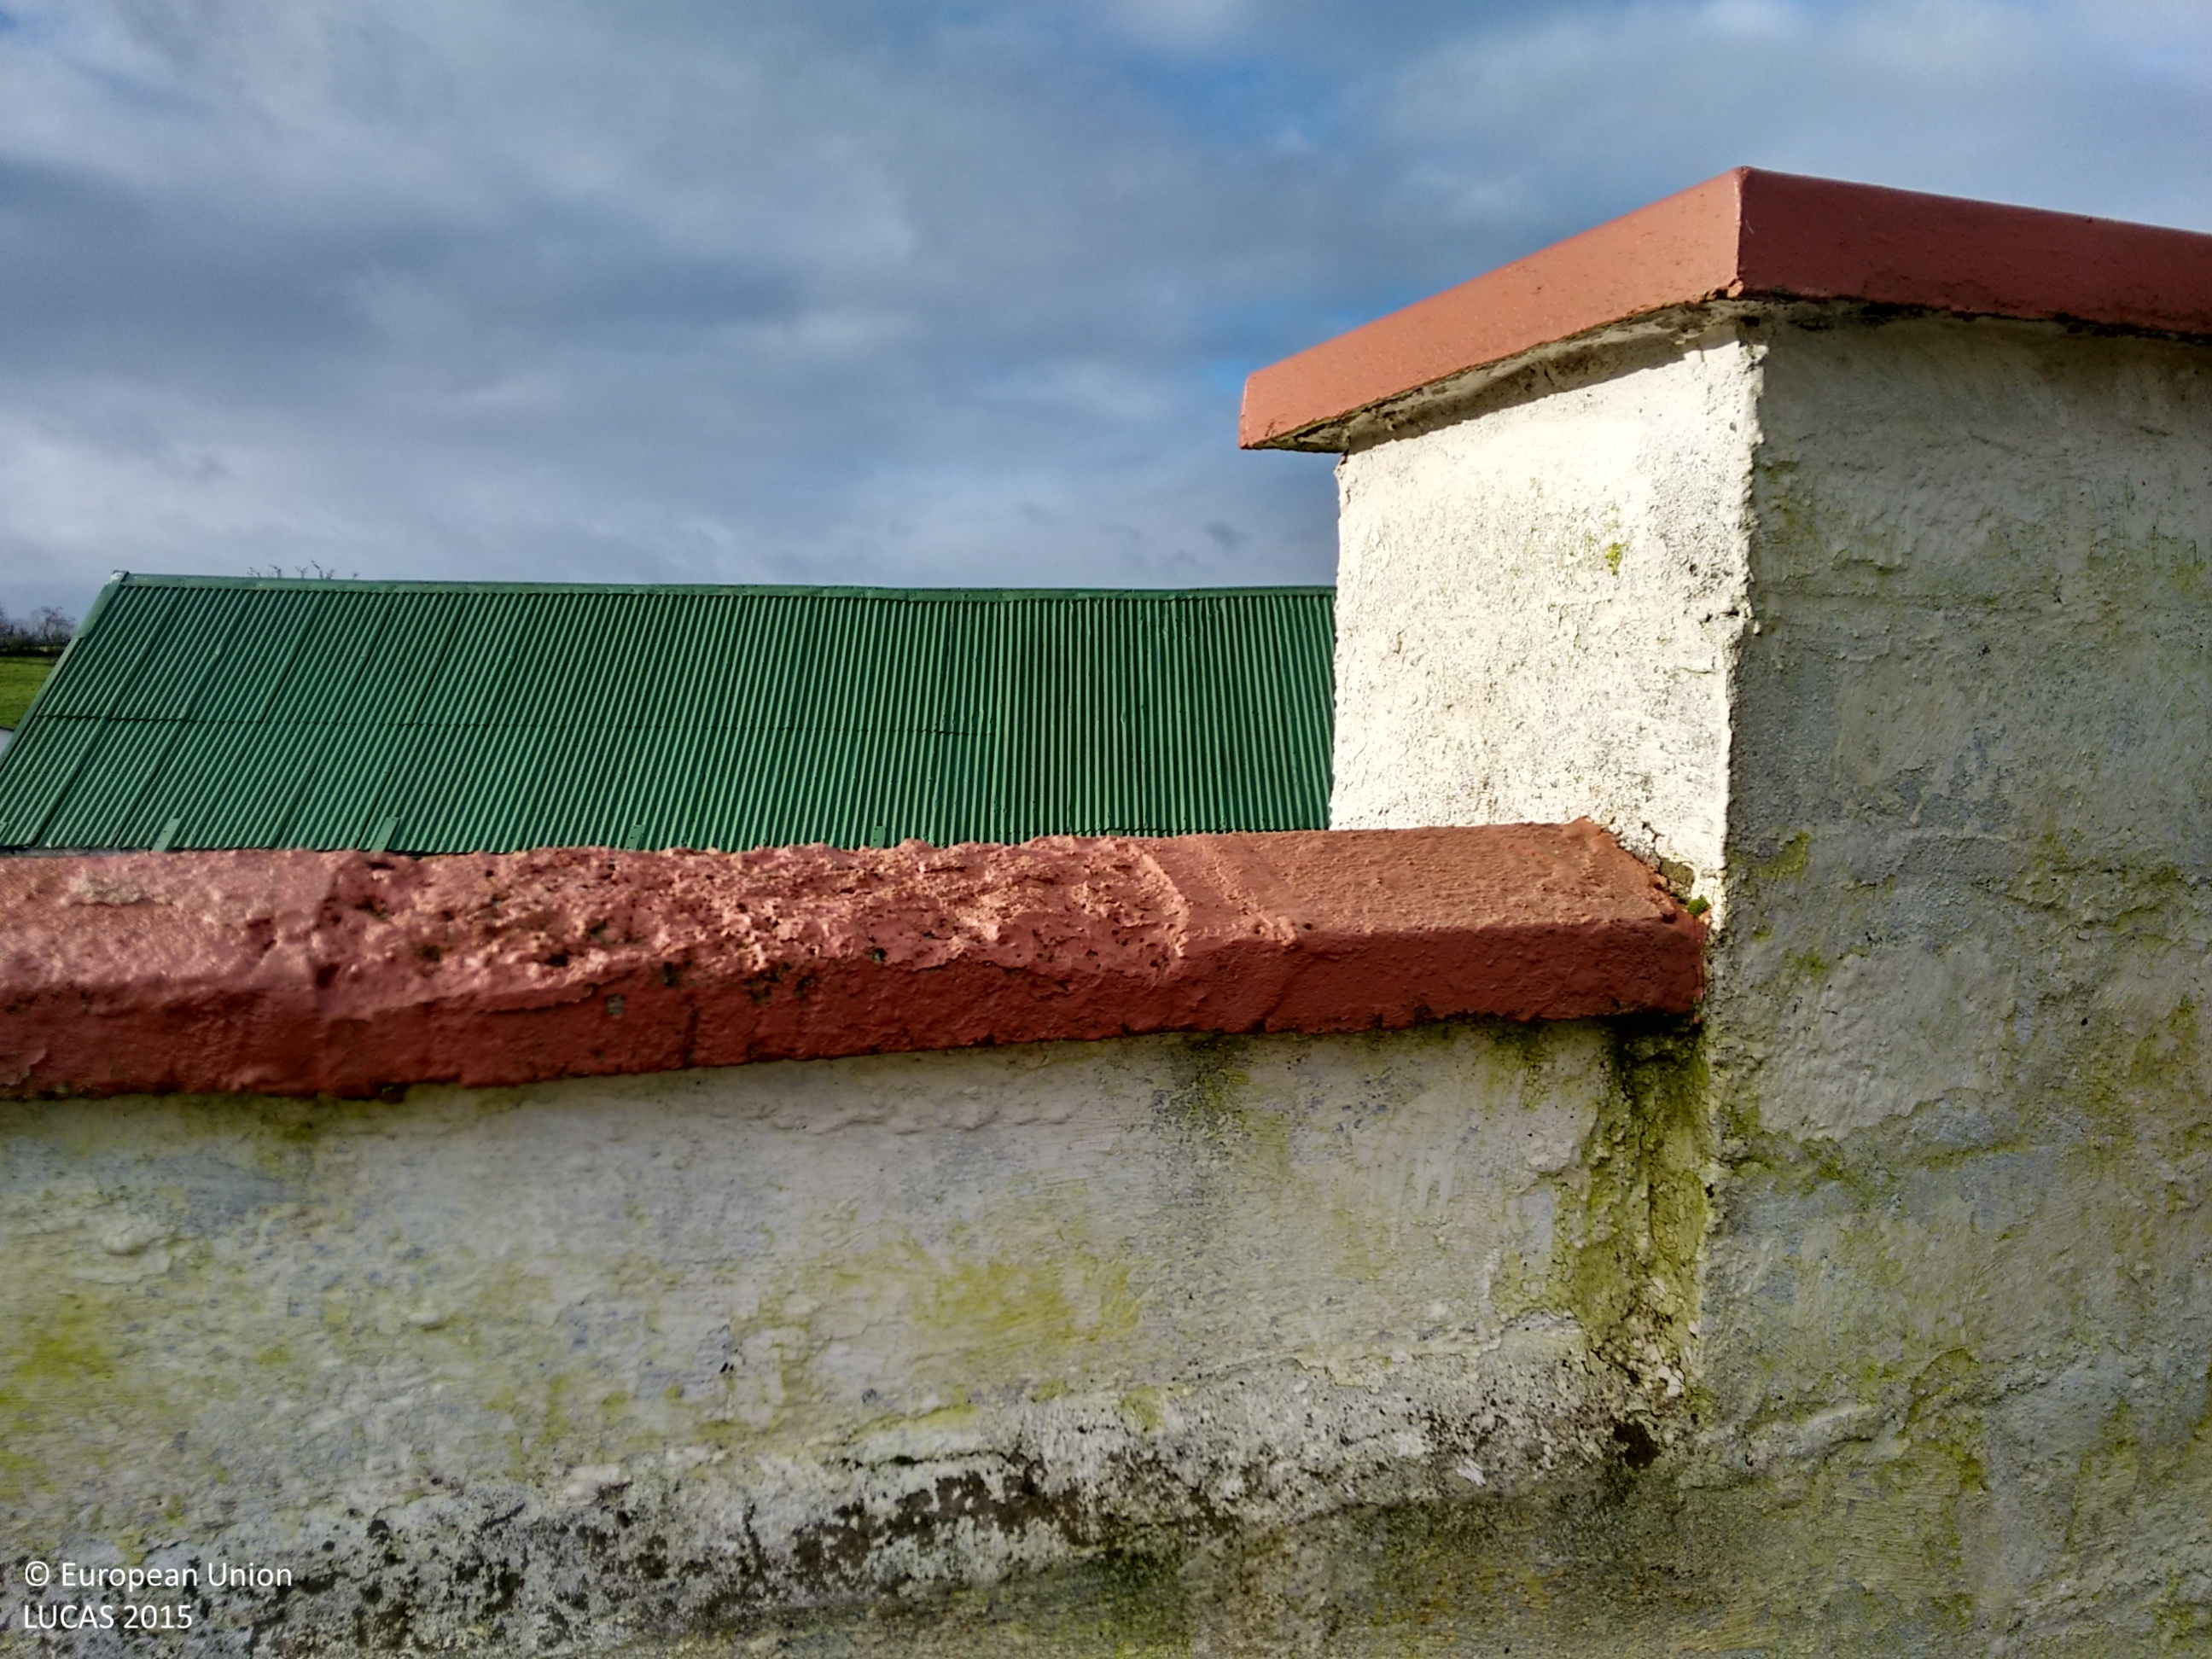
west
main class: Grassland
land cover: Grassland without tree/shrub cover
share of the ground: > 75 %
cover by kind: herbaceous plants 100 %
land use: Agriculture (excluding fallow land and kitchen gardens)
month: December
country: IE
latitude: 53.9334
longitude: -6.7507
